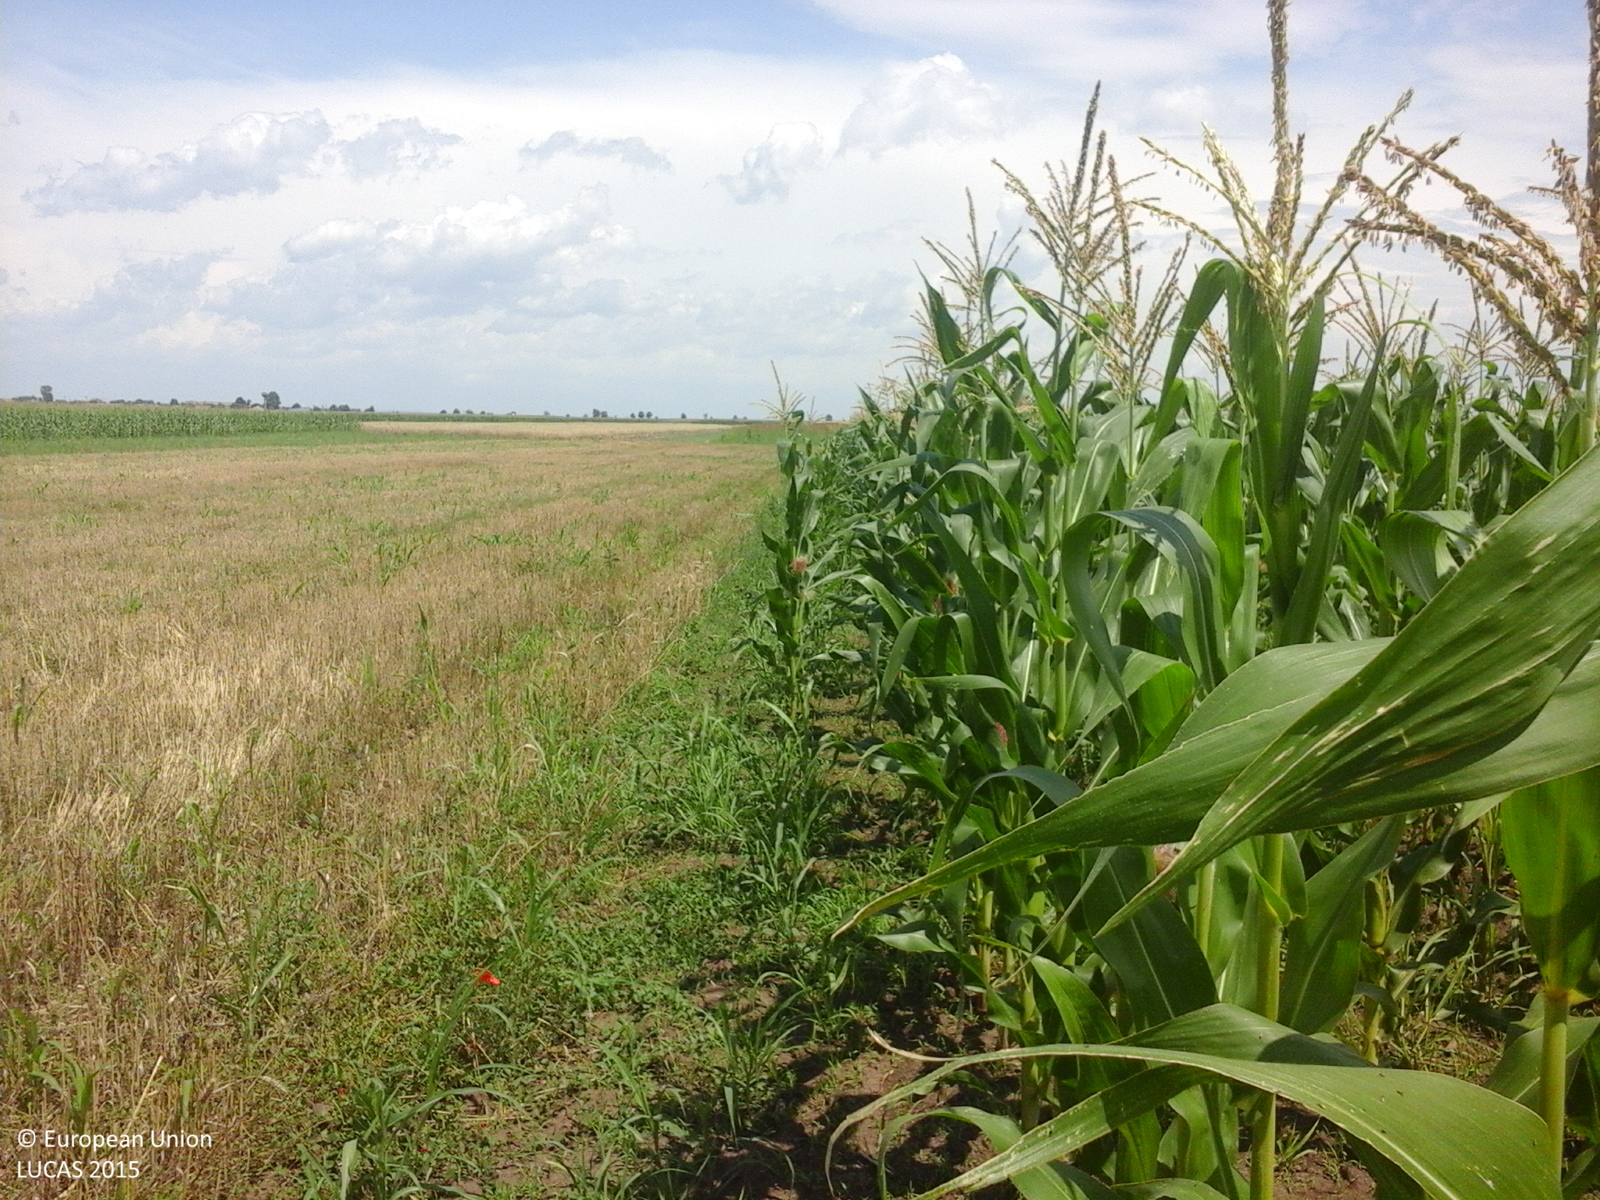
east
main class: Cropland
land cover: Maize
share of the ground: > 75 %
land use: Agriculture (excluding fallow land and kitchen gardens)
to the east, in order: Maize; Common wheat; Tracks; Common wheat
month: July
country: RO
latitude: 43.8480
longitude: 24.4310
